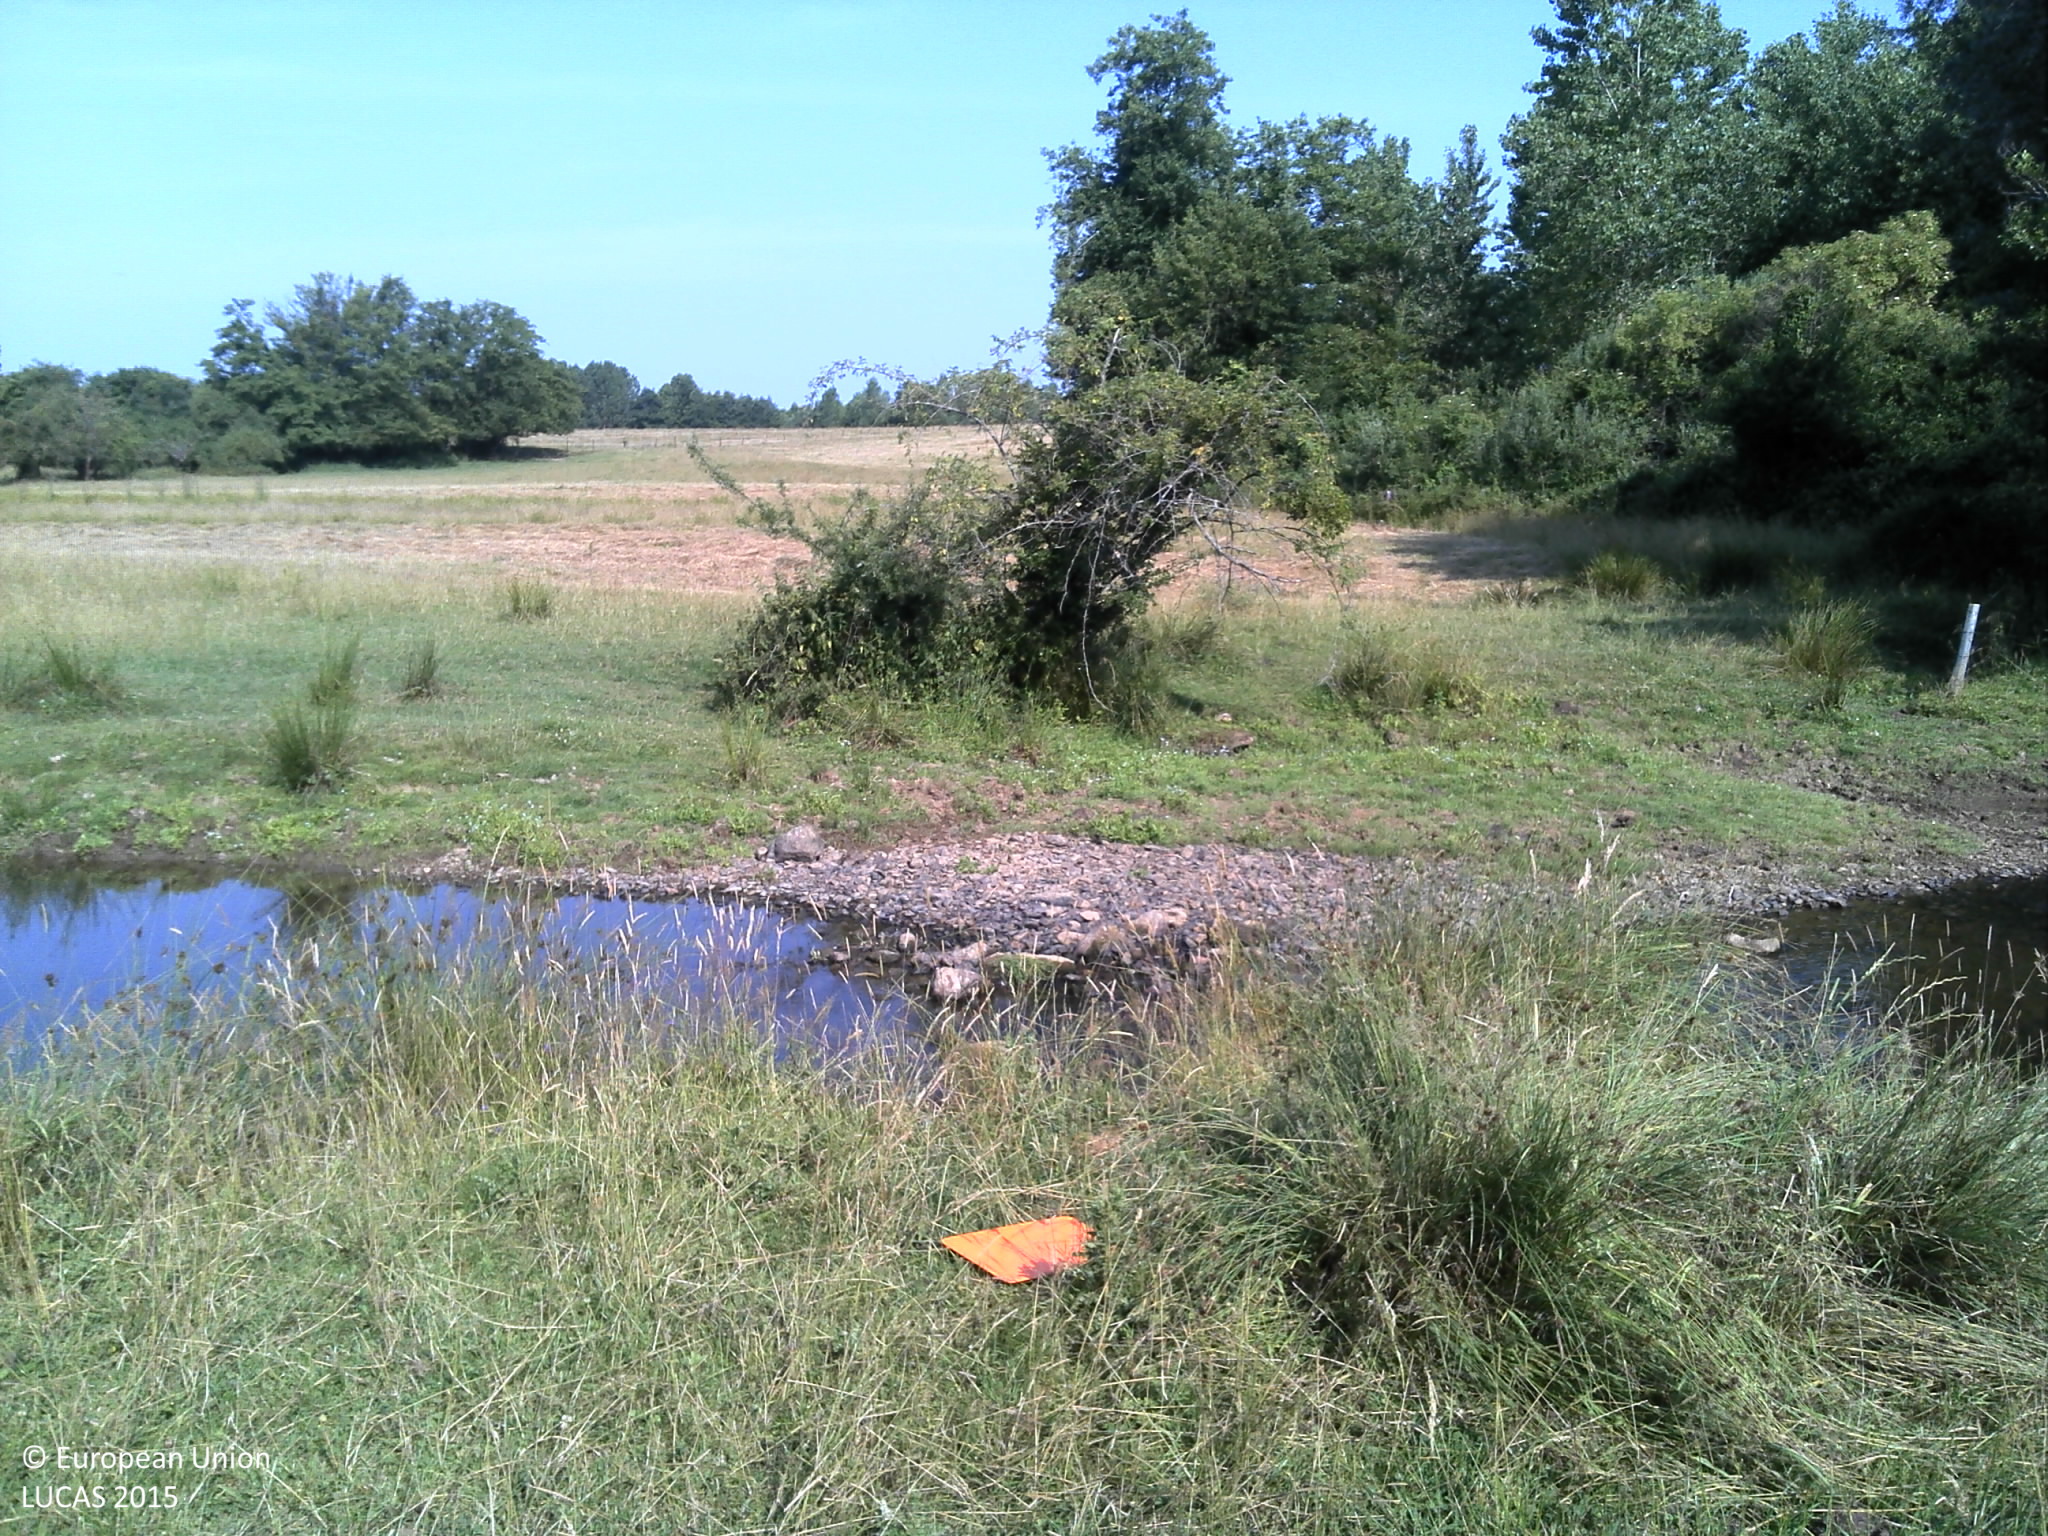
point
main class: Grassland
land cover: Grassland without tree/shrub cover
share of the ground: > 75 %
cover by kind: herbaceous plants 100 %
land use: Agriculture (excluding fallow land and kitchen gardens)
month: July
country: FR
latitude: 49.8341
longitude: 4.4764
